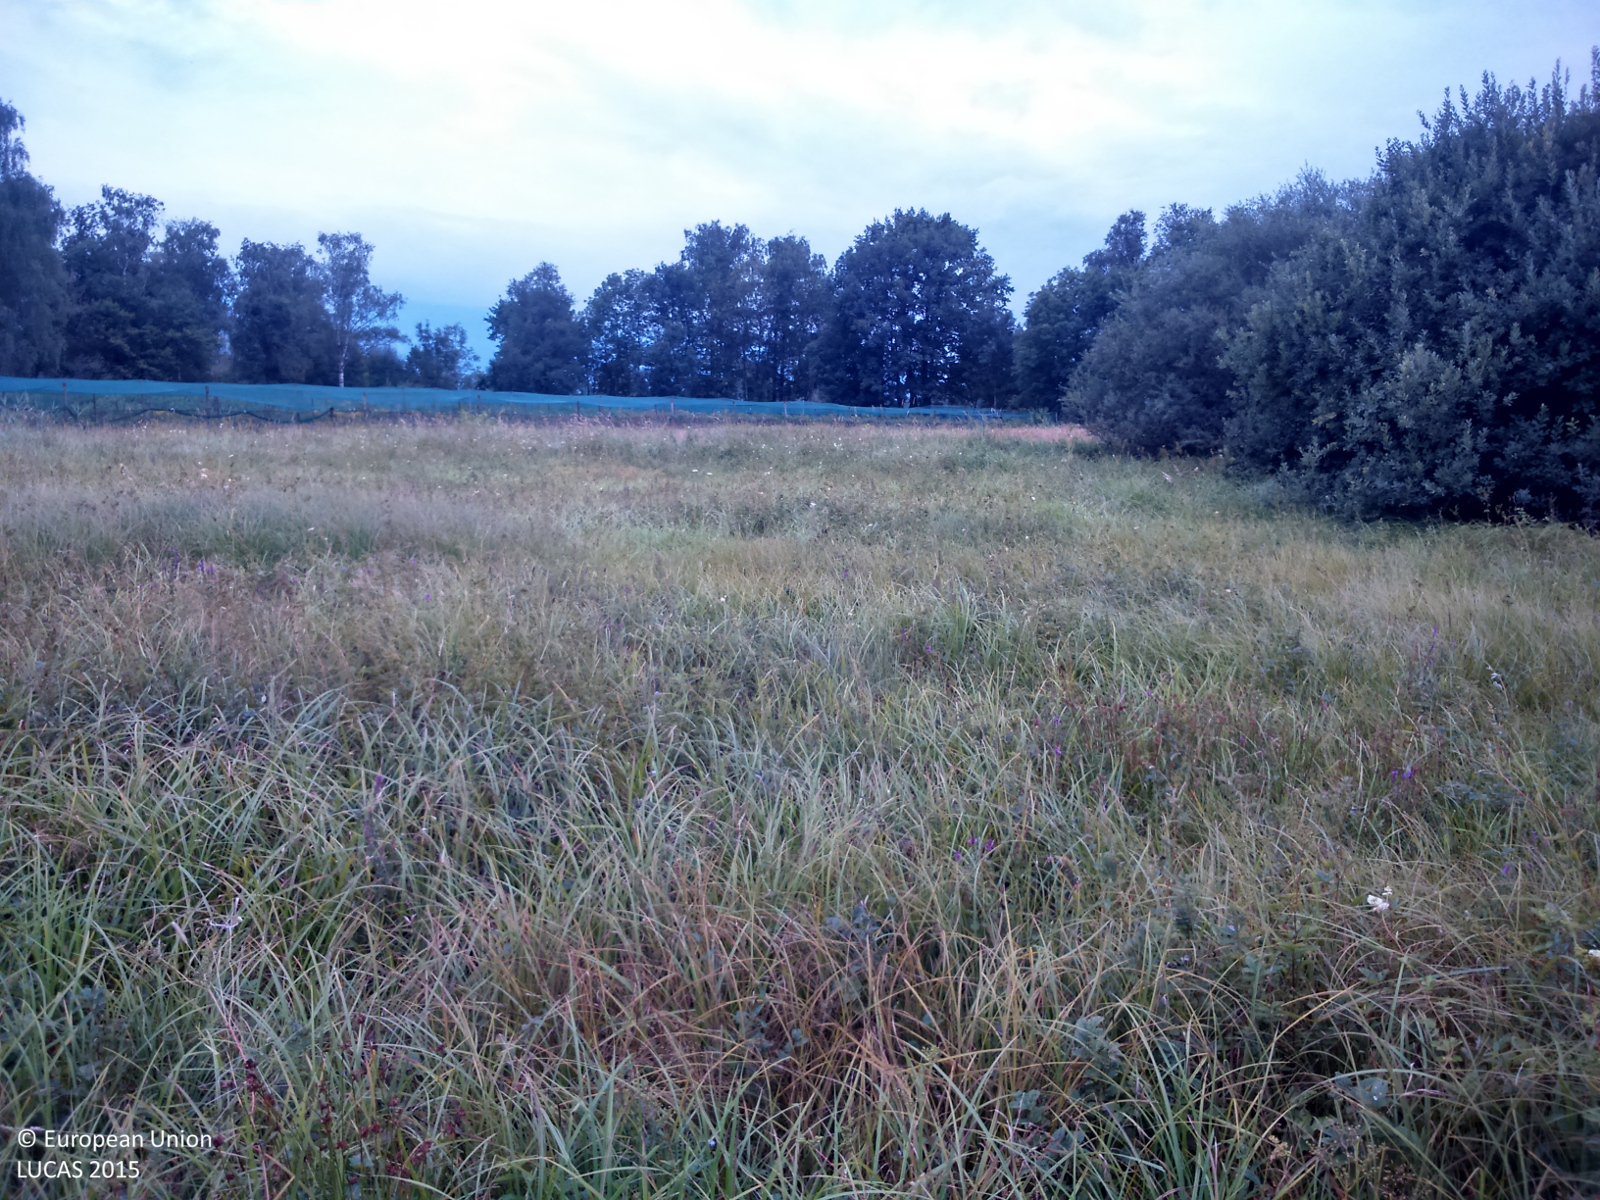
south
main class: Grassland
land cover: Grassland without tree/shrub cover
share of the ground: > 75 %
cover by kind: herbaceous plants 100 %
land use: Agriculture (excluding fallow land and kitchen gardens)
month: August
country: AT
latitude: 47.4672
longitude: 9.6951
